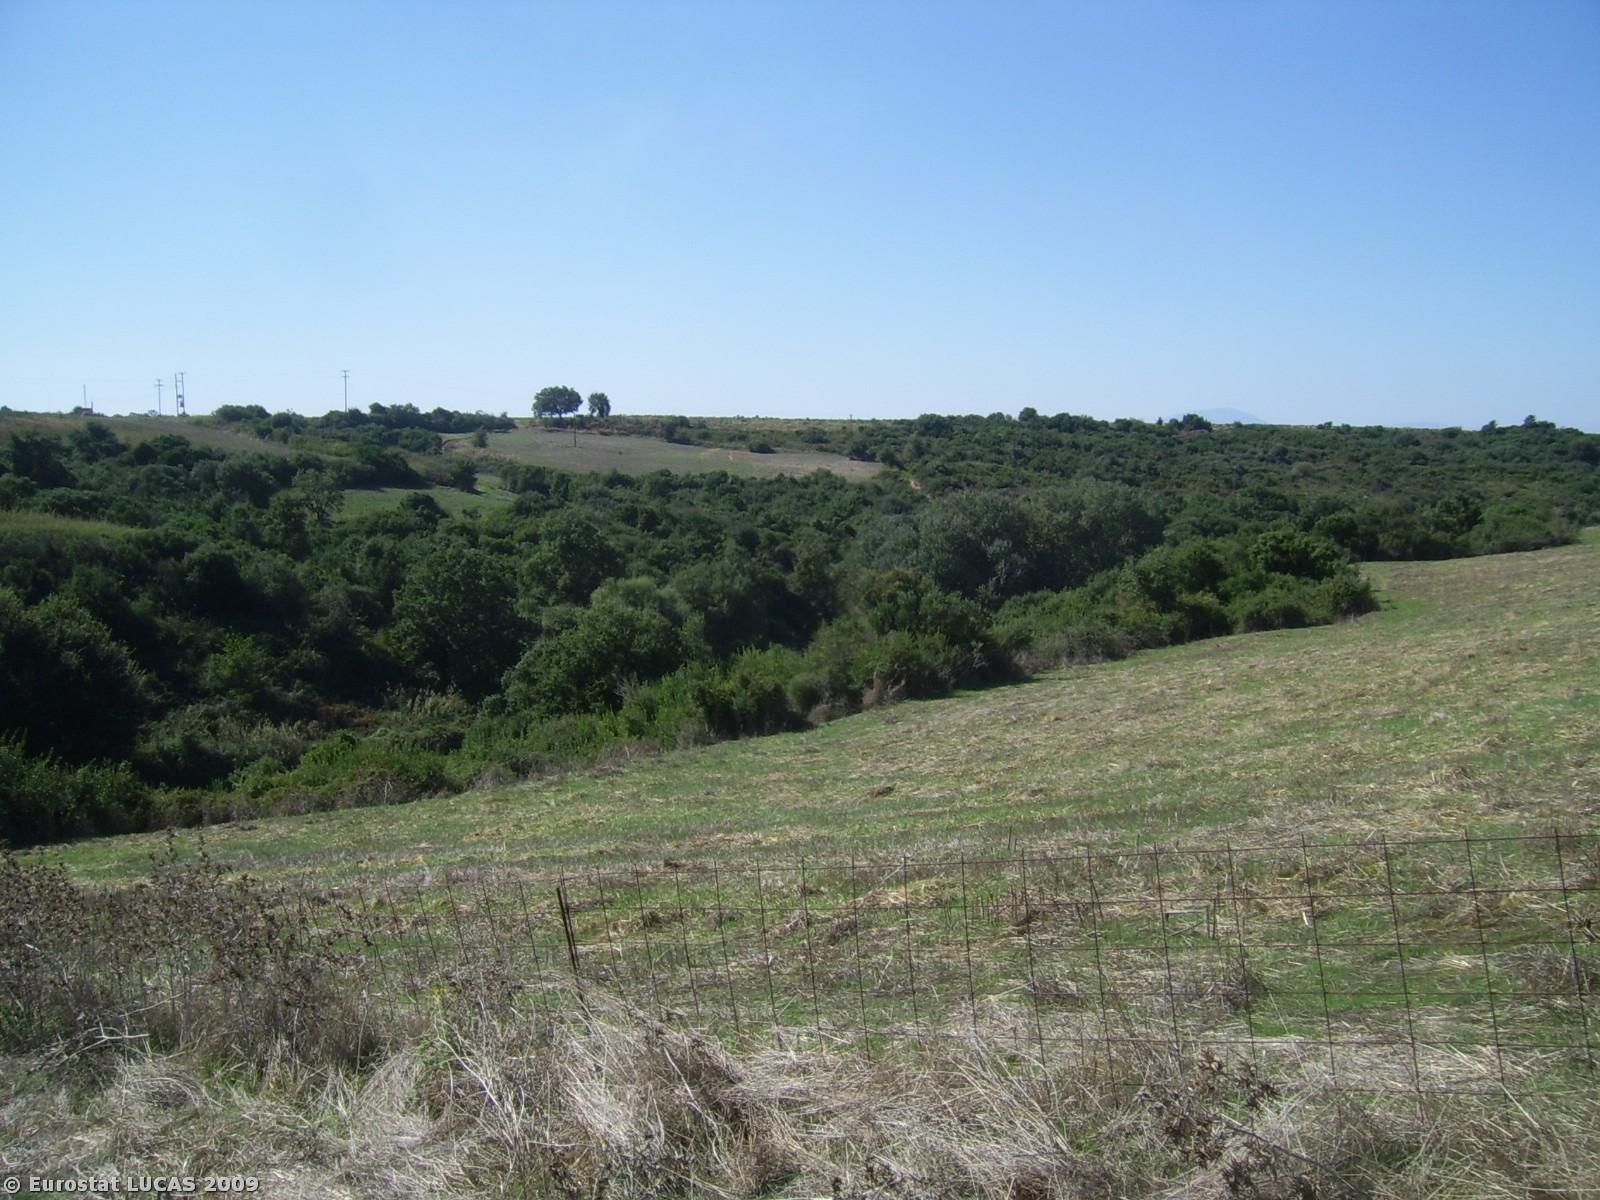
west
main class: Grassland
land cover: Grassland without tree/shrub cover
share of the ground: > 75 %
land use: Agriculture (excluding fallow land and kitchen gardens)
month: October
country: GR
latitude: 37.9408
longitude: 21.3746
